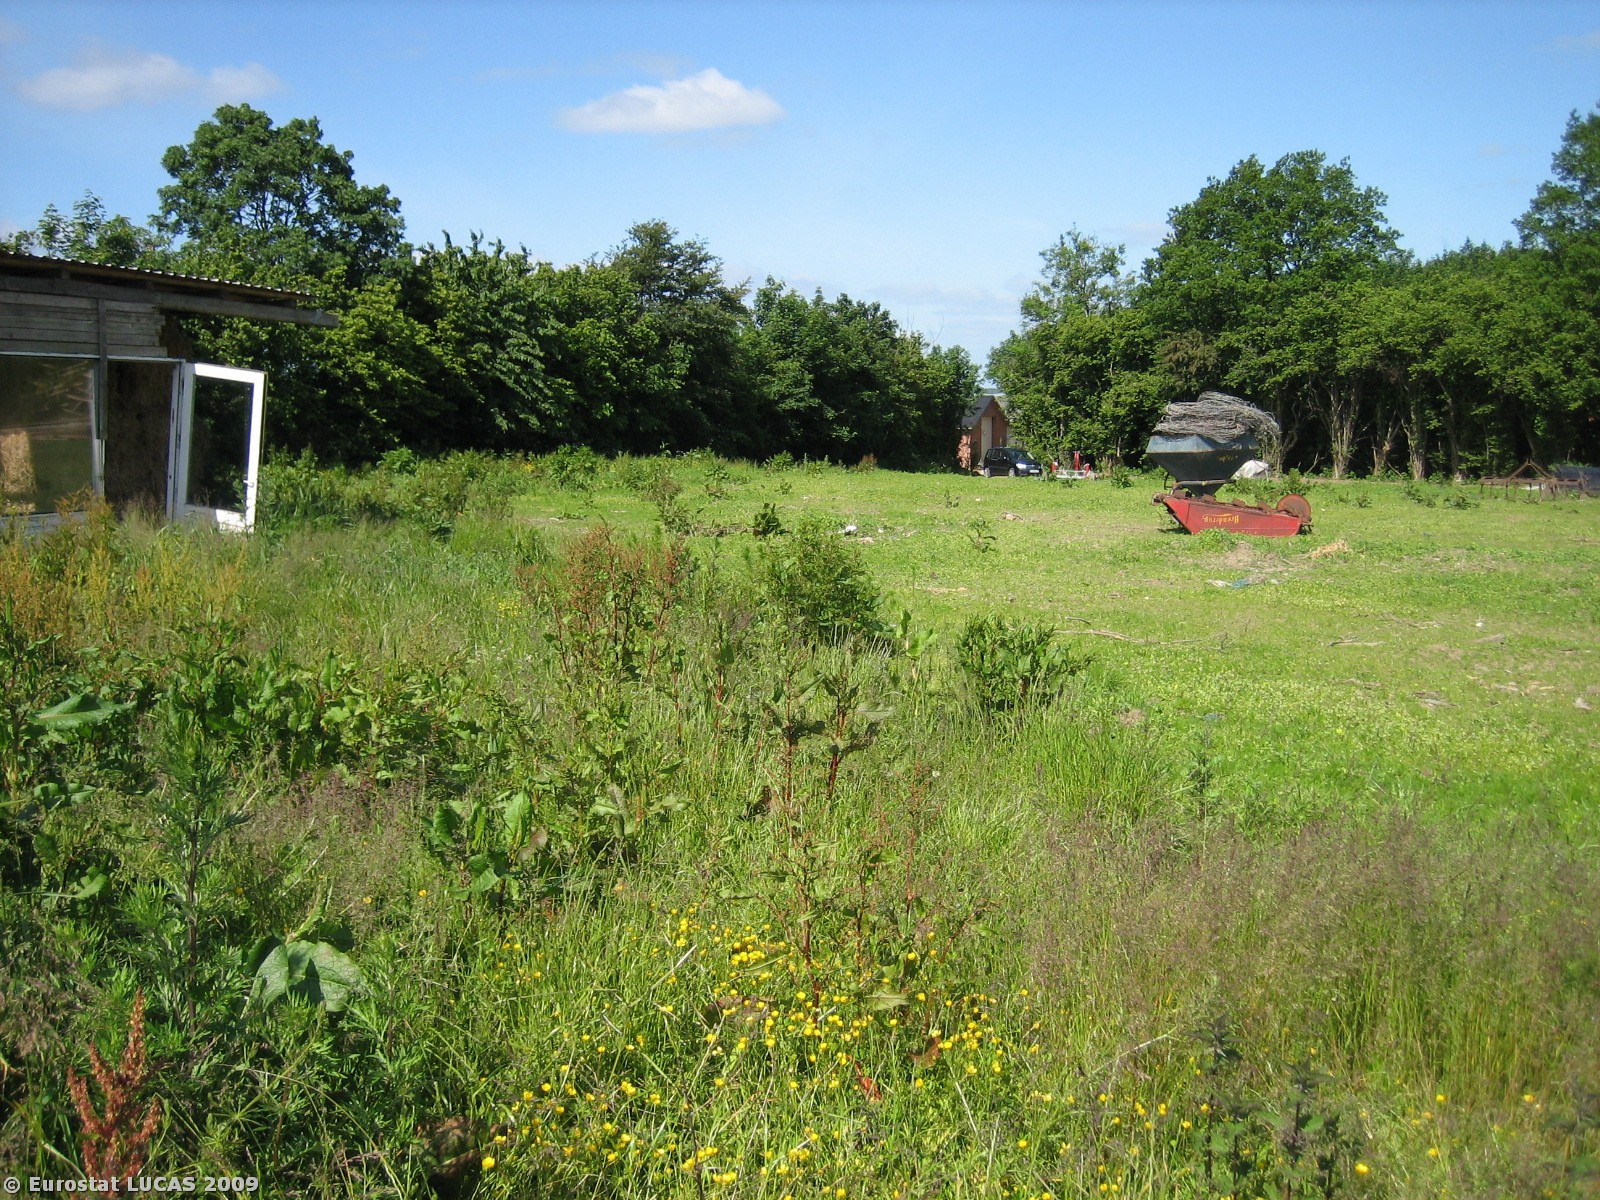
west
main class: Cropland
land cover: Common wheat
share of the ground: > 75 %
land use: Agriculture (excluding fallow land and kitchen gardens)
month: June
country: DK
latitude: 55.7563
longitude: 9.8886
